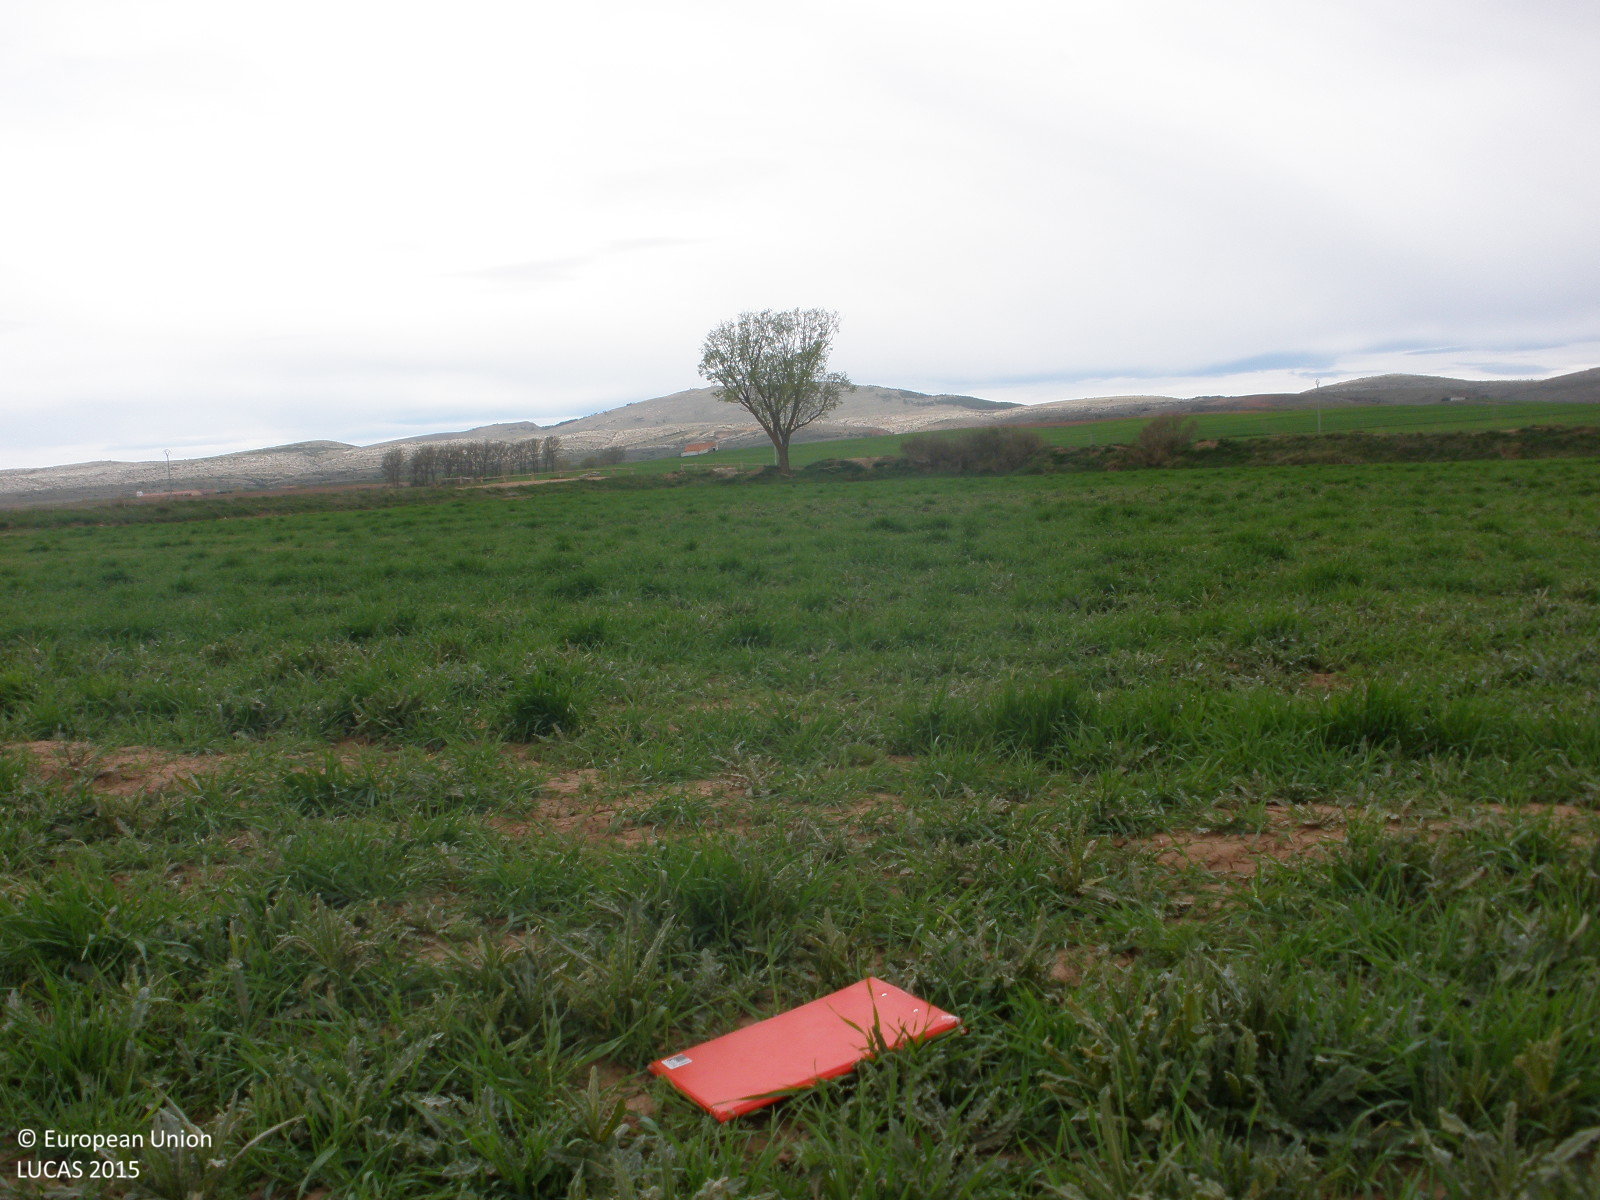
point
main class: Cropland
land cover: Barley
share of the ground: > 75 %
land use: Agriculture (excluding fallow land and kitchen gardens)
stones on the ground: < 10 %
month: May
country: ES
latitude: 40.4842
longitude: -0.8518
